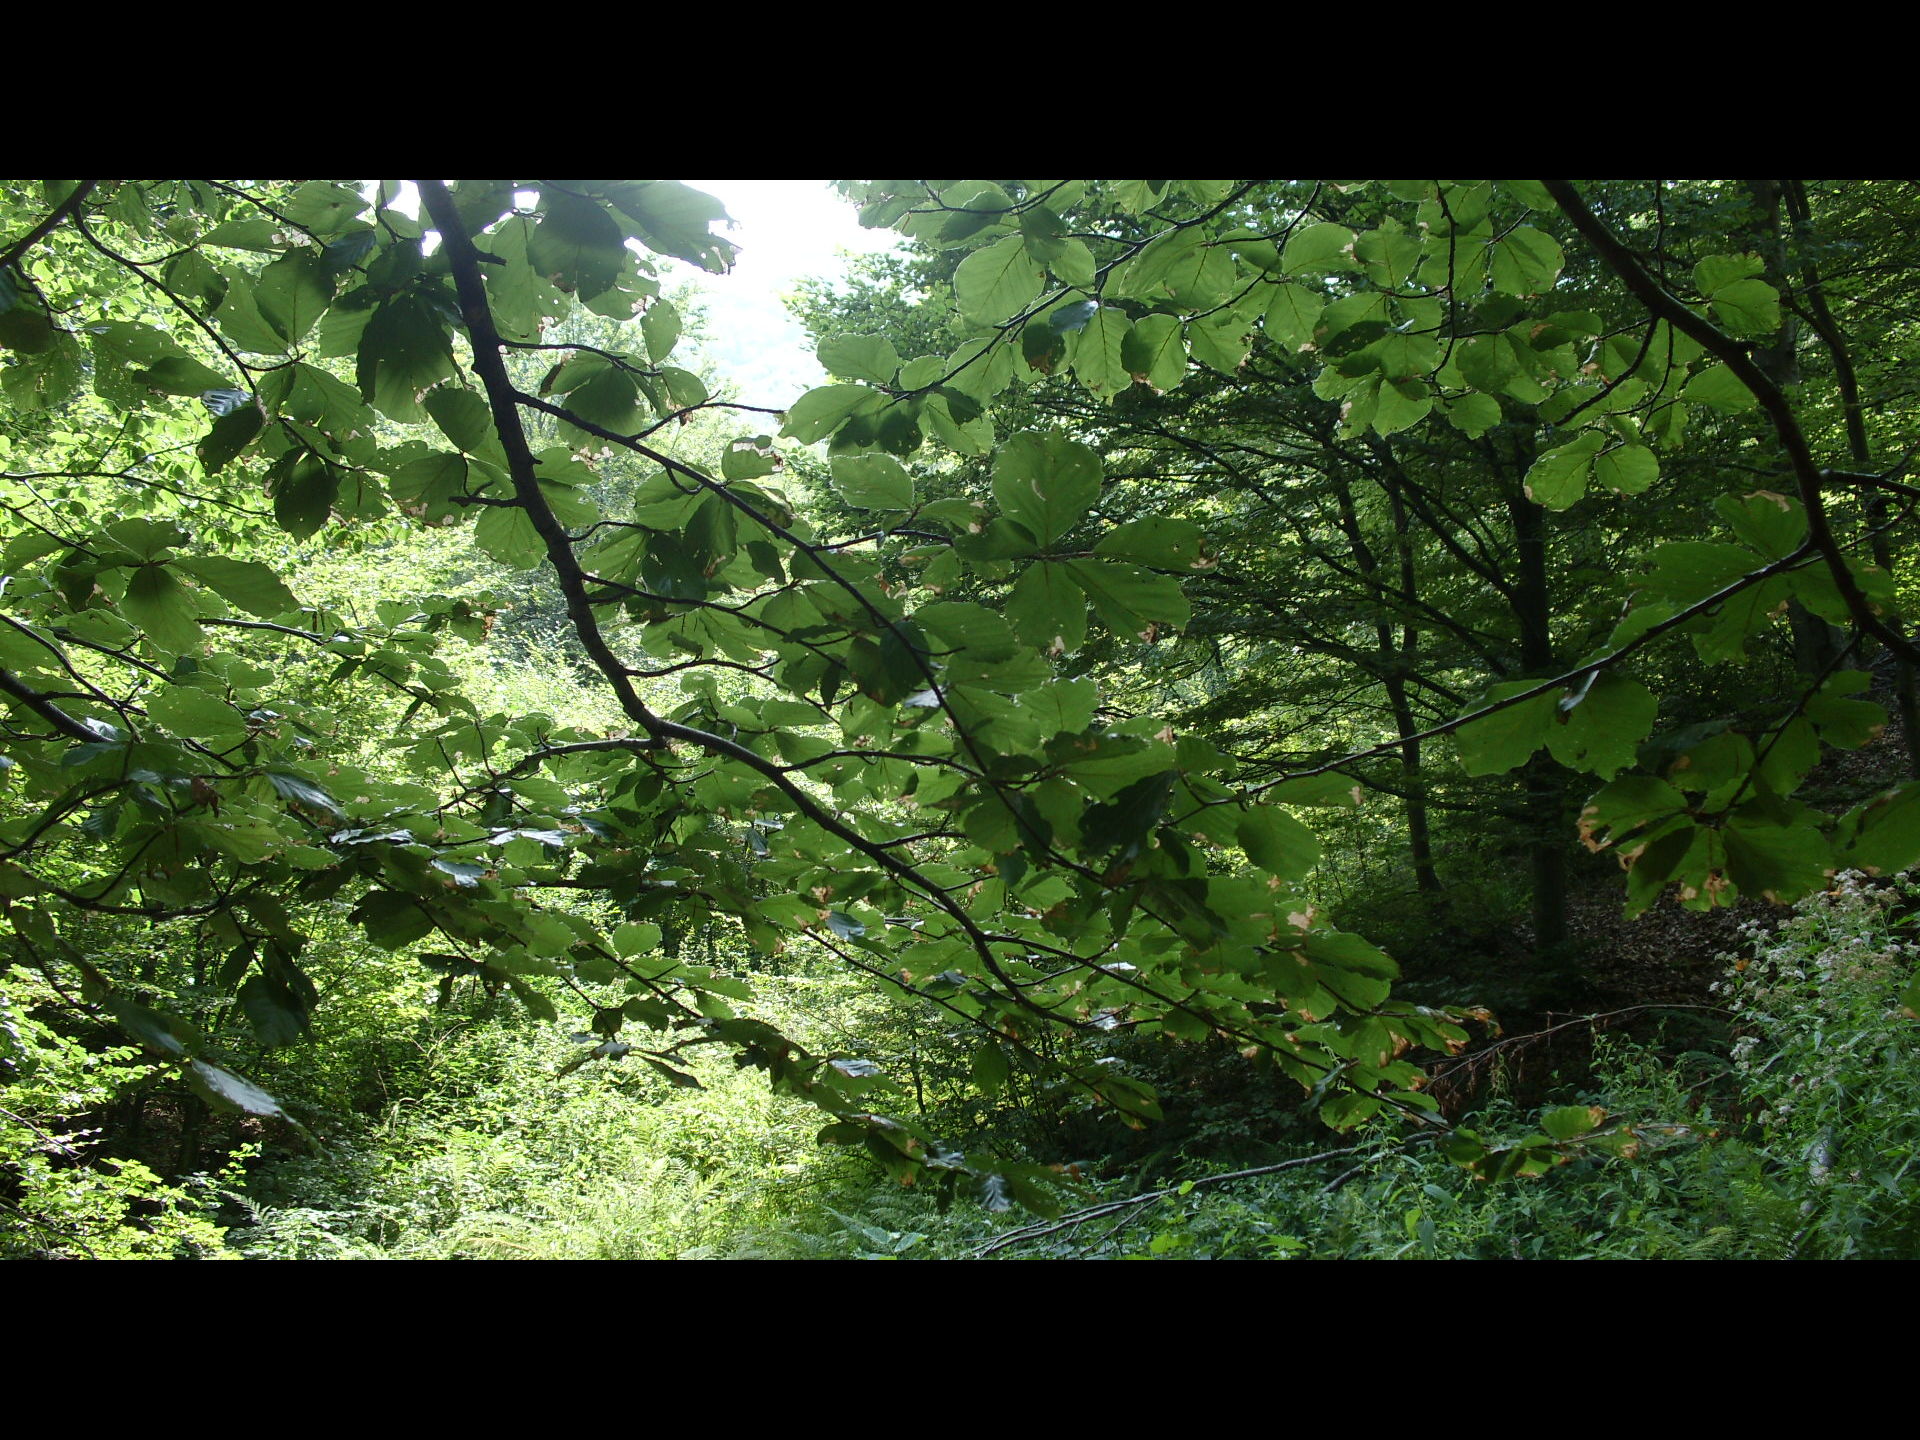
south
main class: Woodland
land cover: Broadleaved woodland
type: beech forest
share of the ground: > 75 %
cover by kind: broadleaved forest trees 90 %, shrubs 5 %, herbaceous plants 5 %
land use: Forestry
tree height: > 5 m
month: August
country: BG
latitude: 43.1520
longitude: 23.2321
